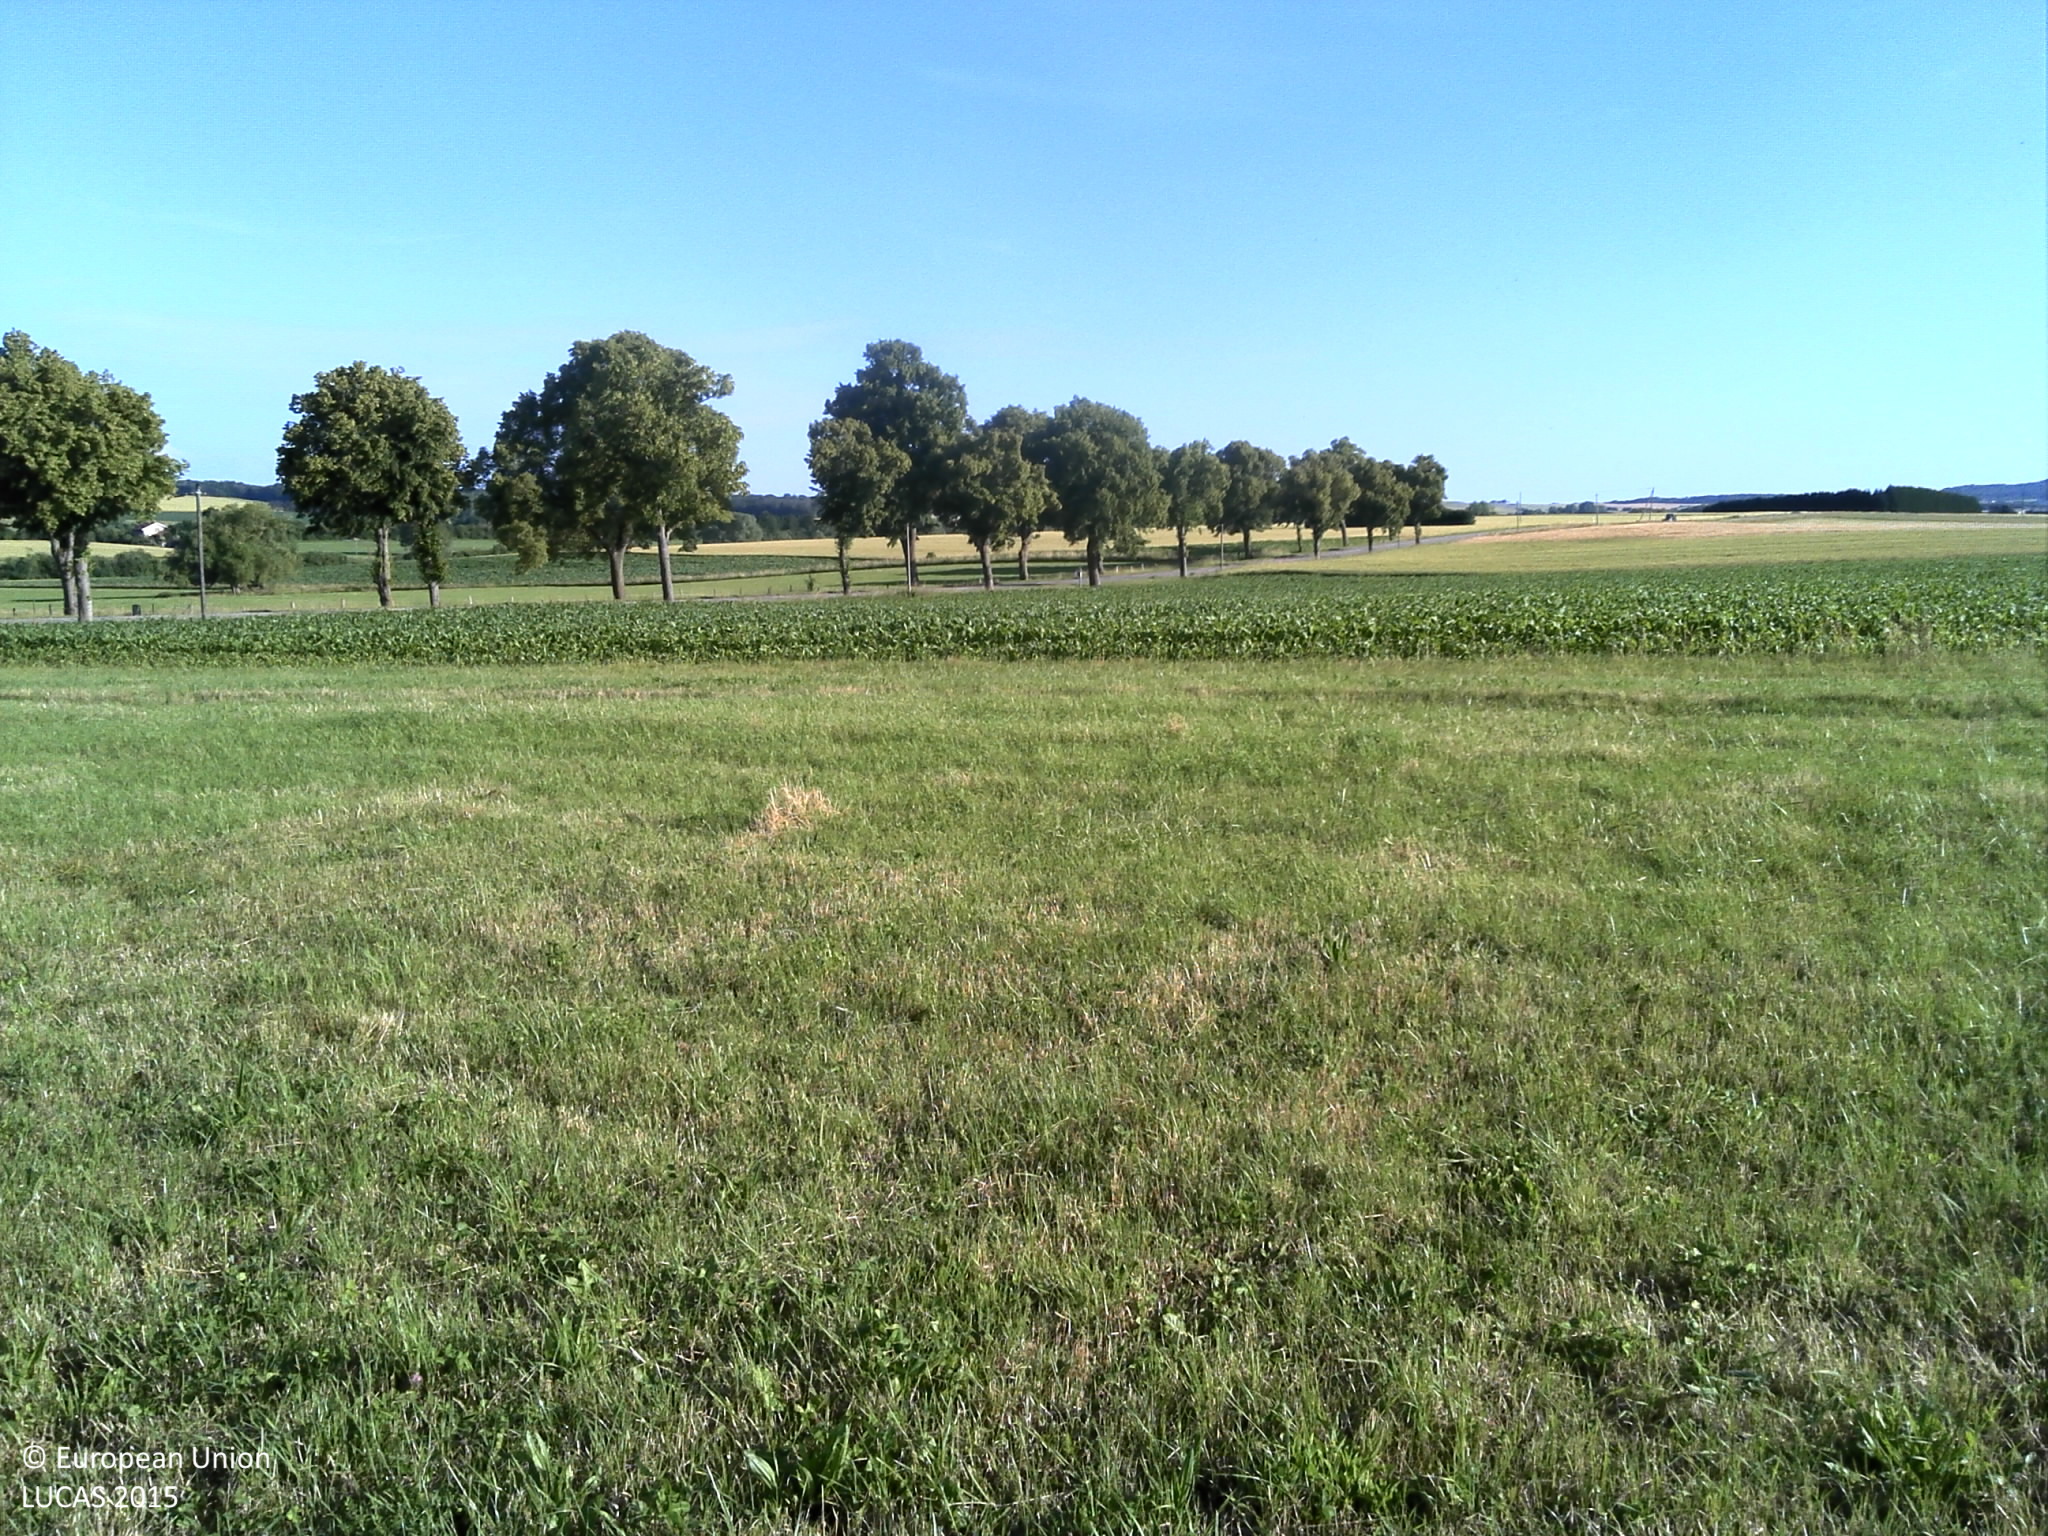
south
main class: Grassland
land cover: Grassland without tree/shrub cover
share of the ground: > 75 %
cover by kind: herbaceous plants 100 %
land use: Agriculture (excluding fallow land and kitchen gardens)
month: June
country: FR
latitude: 48.9511
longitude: 6.7913
